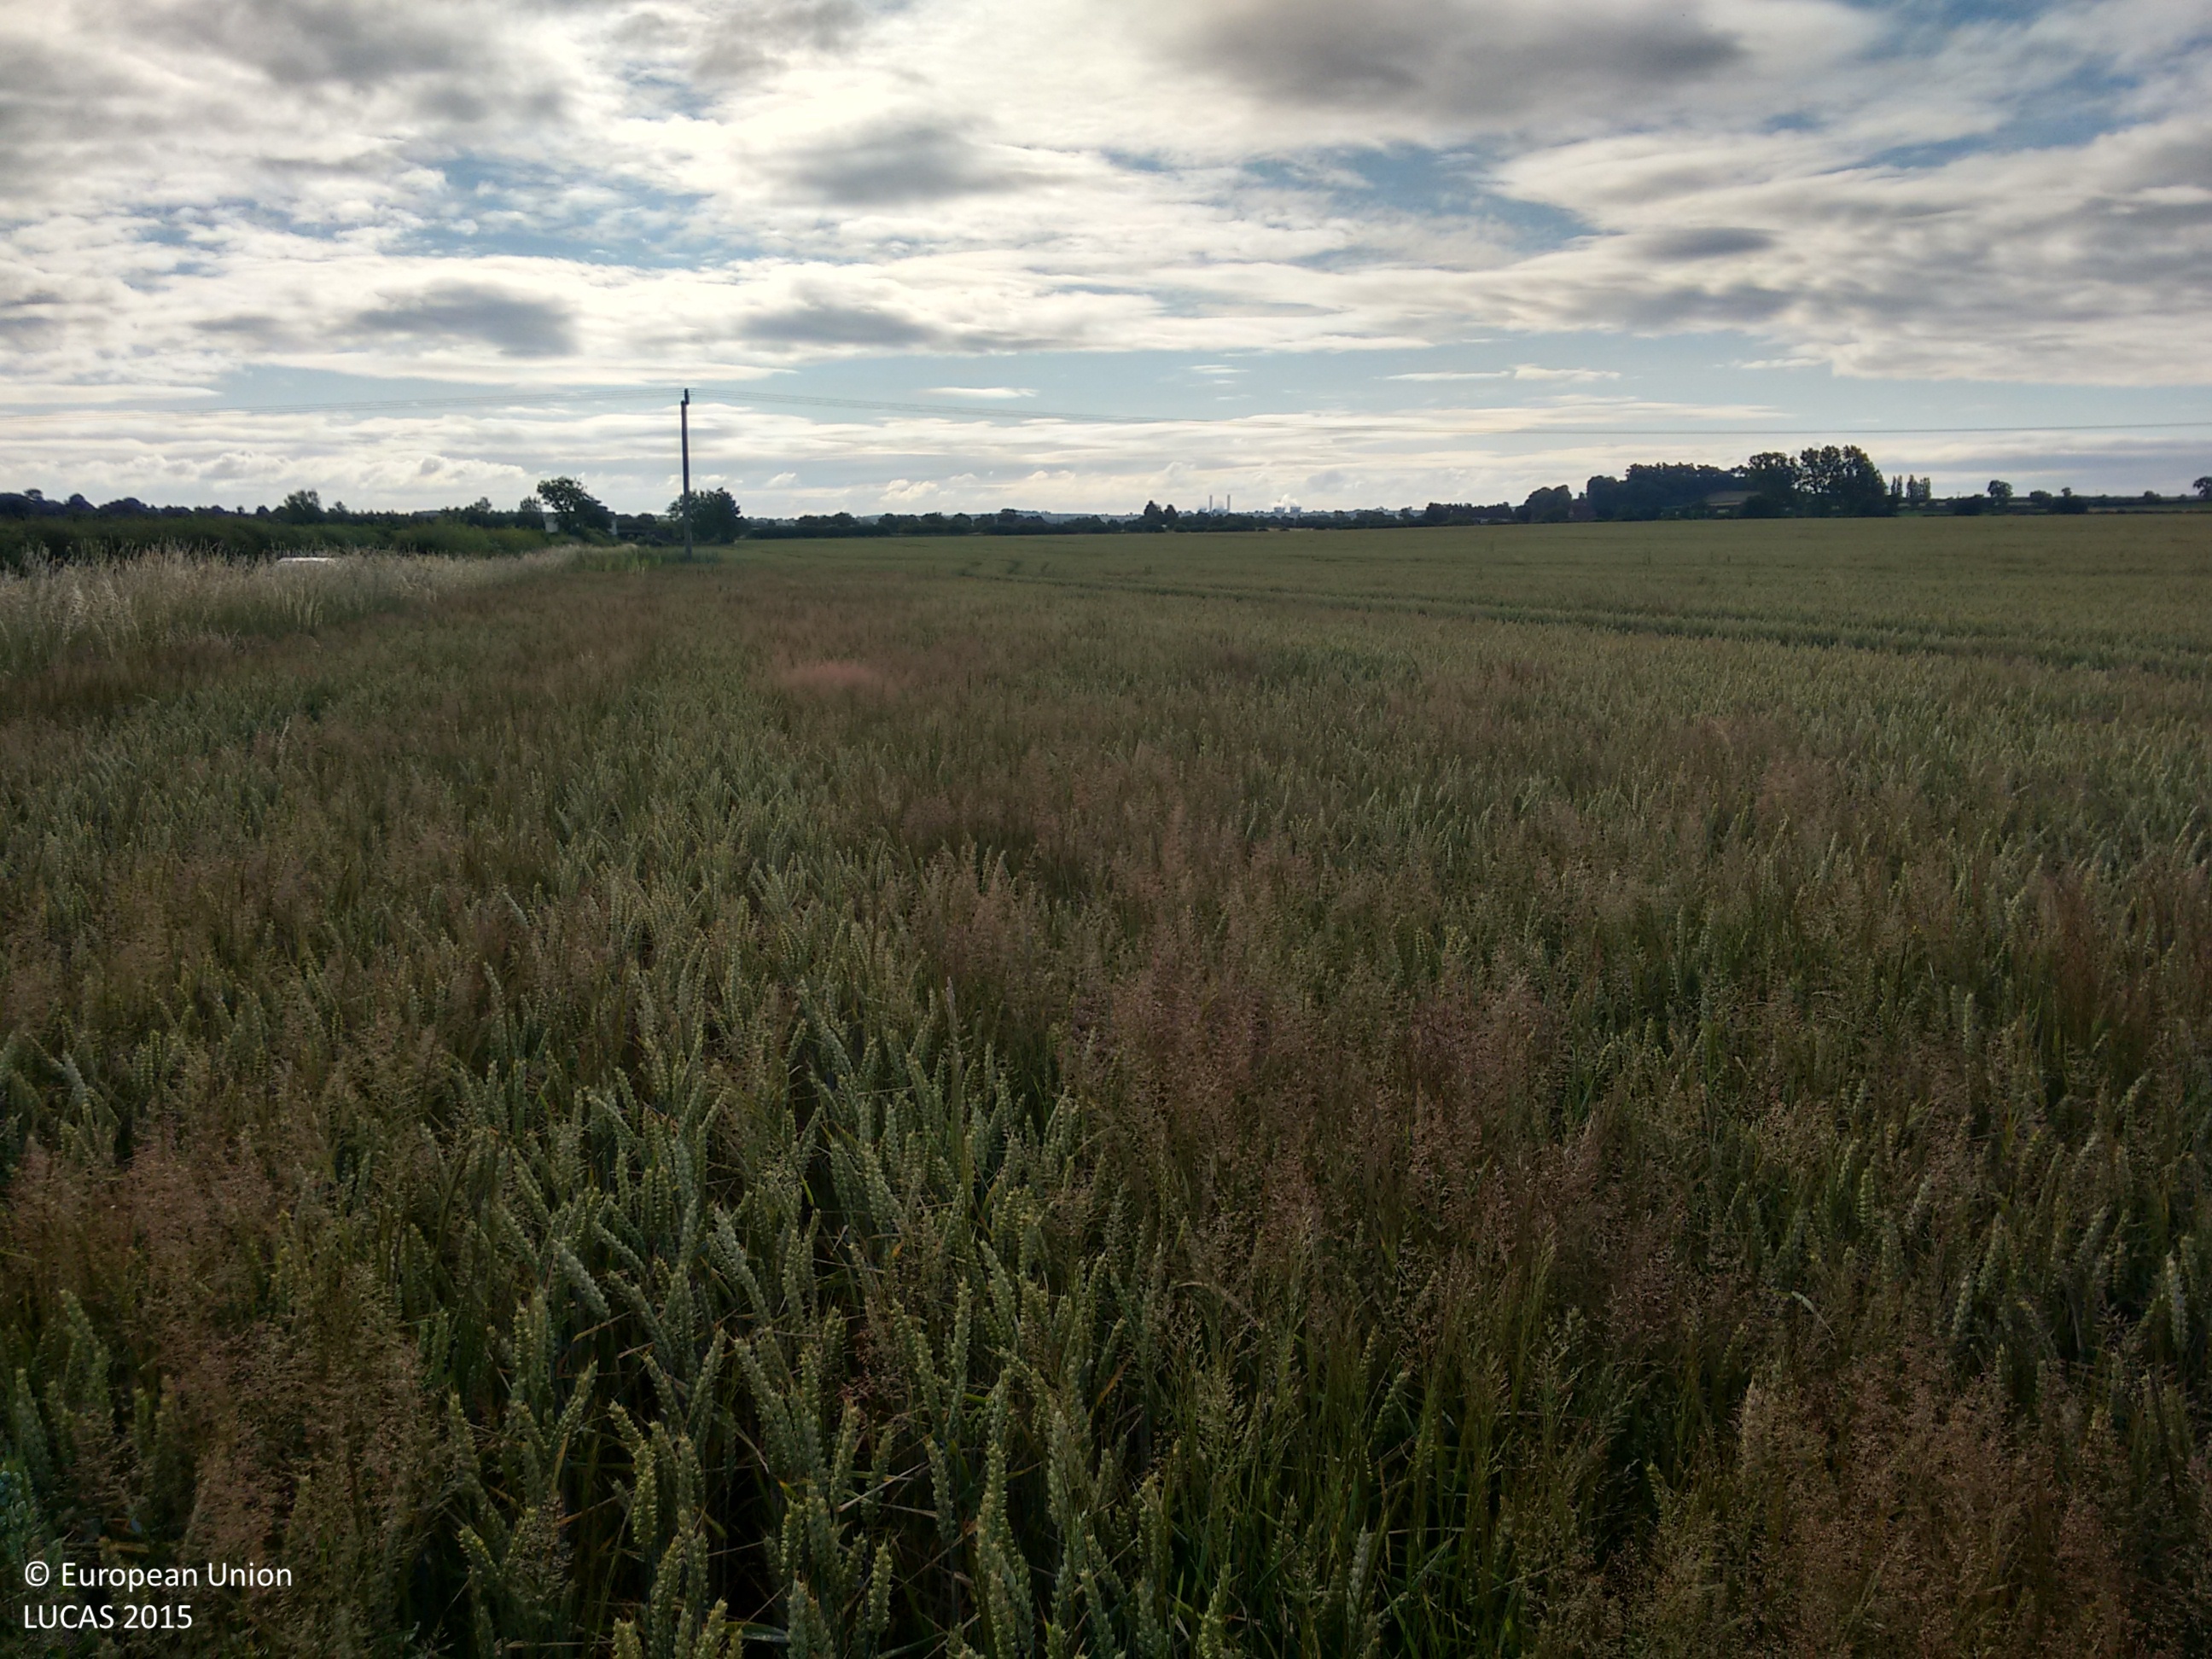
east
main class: Cropland
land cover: Common wheat
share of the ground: > 75 %
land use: Agriculture (excluding fallow land and kitchen gardens)
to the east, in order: Common wheat; Electric lines; Common wheat
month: July
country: GB
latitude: 53.3915
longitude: -0.9751
